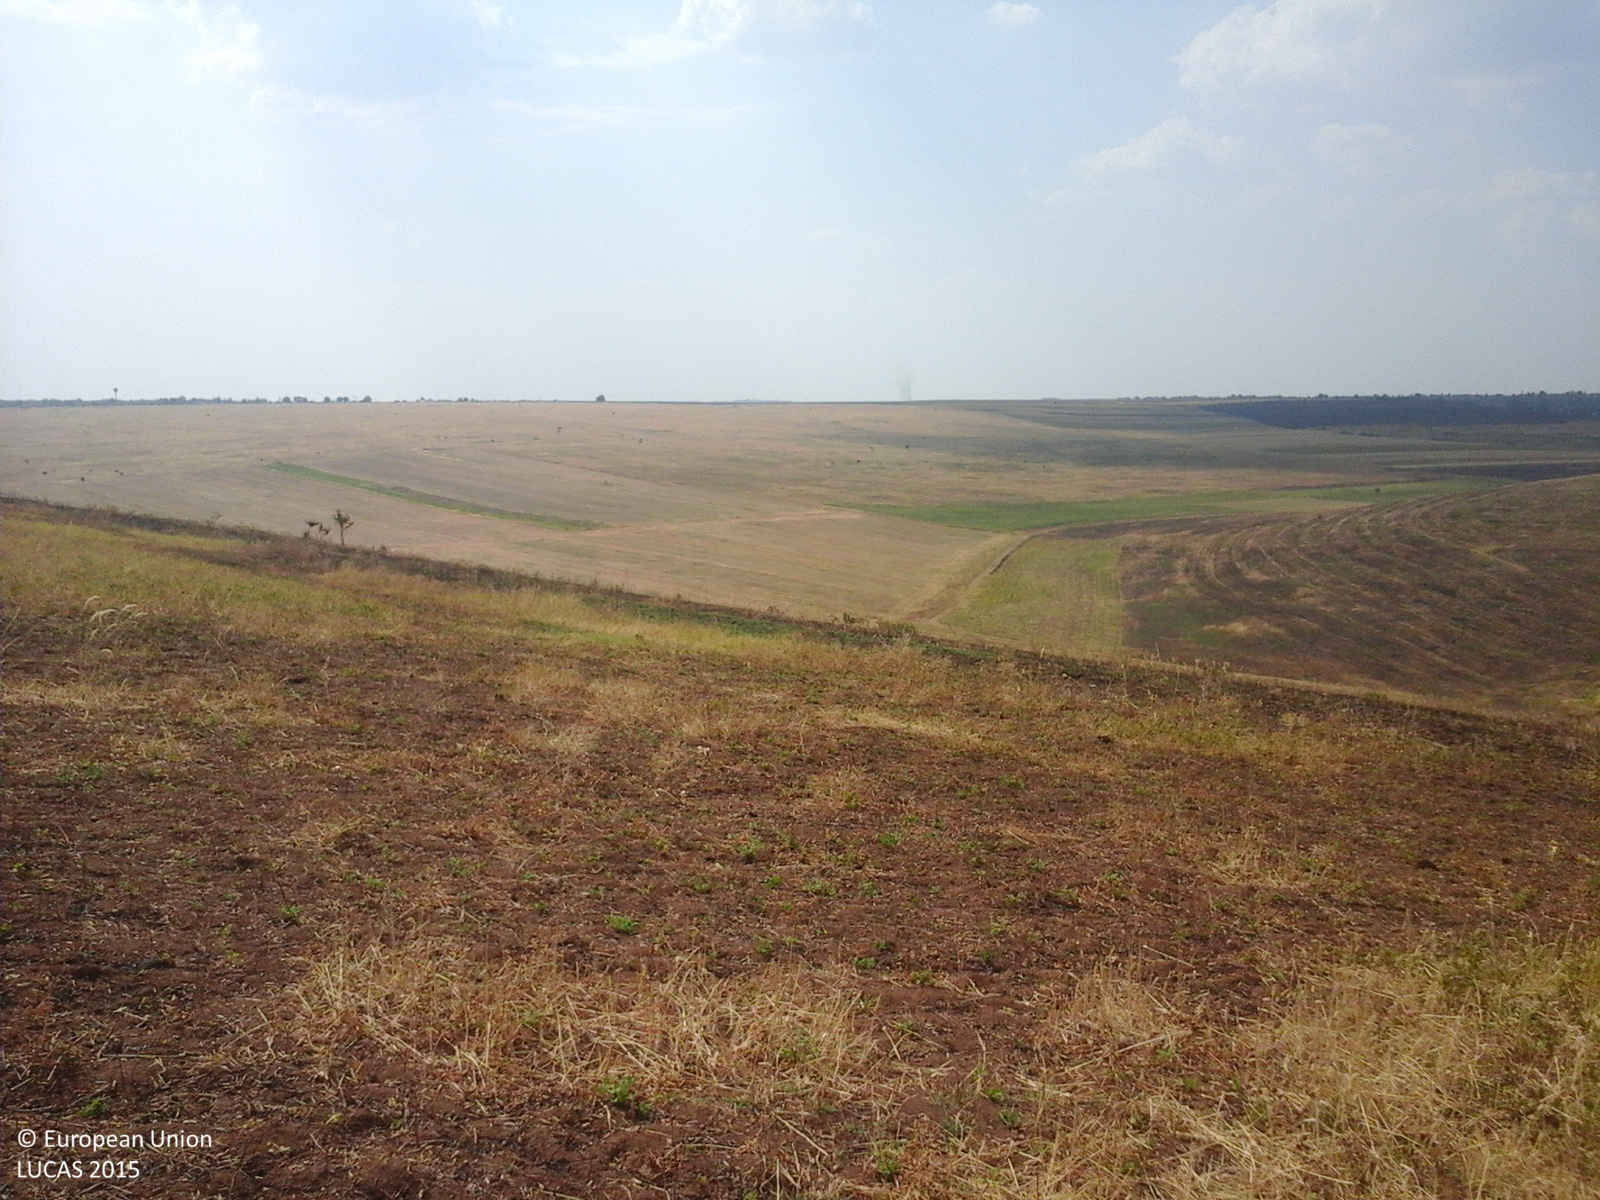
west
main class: Cropland
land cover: Common wheat
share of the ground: < 10 %
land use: Agriculture (excluding fallow land and kitchen gardens)
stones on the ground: < 10 %
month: August
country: RO
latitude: 44.3611
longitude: 23.0567
